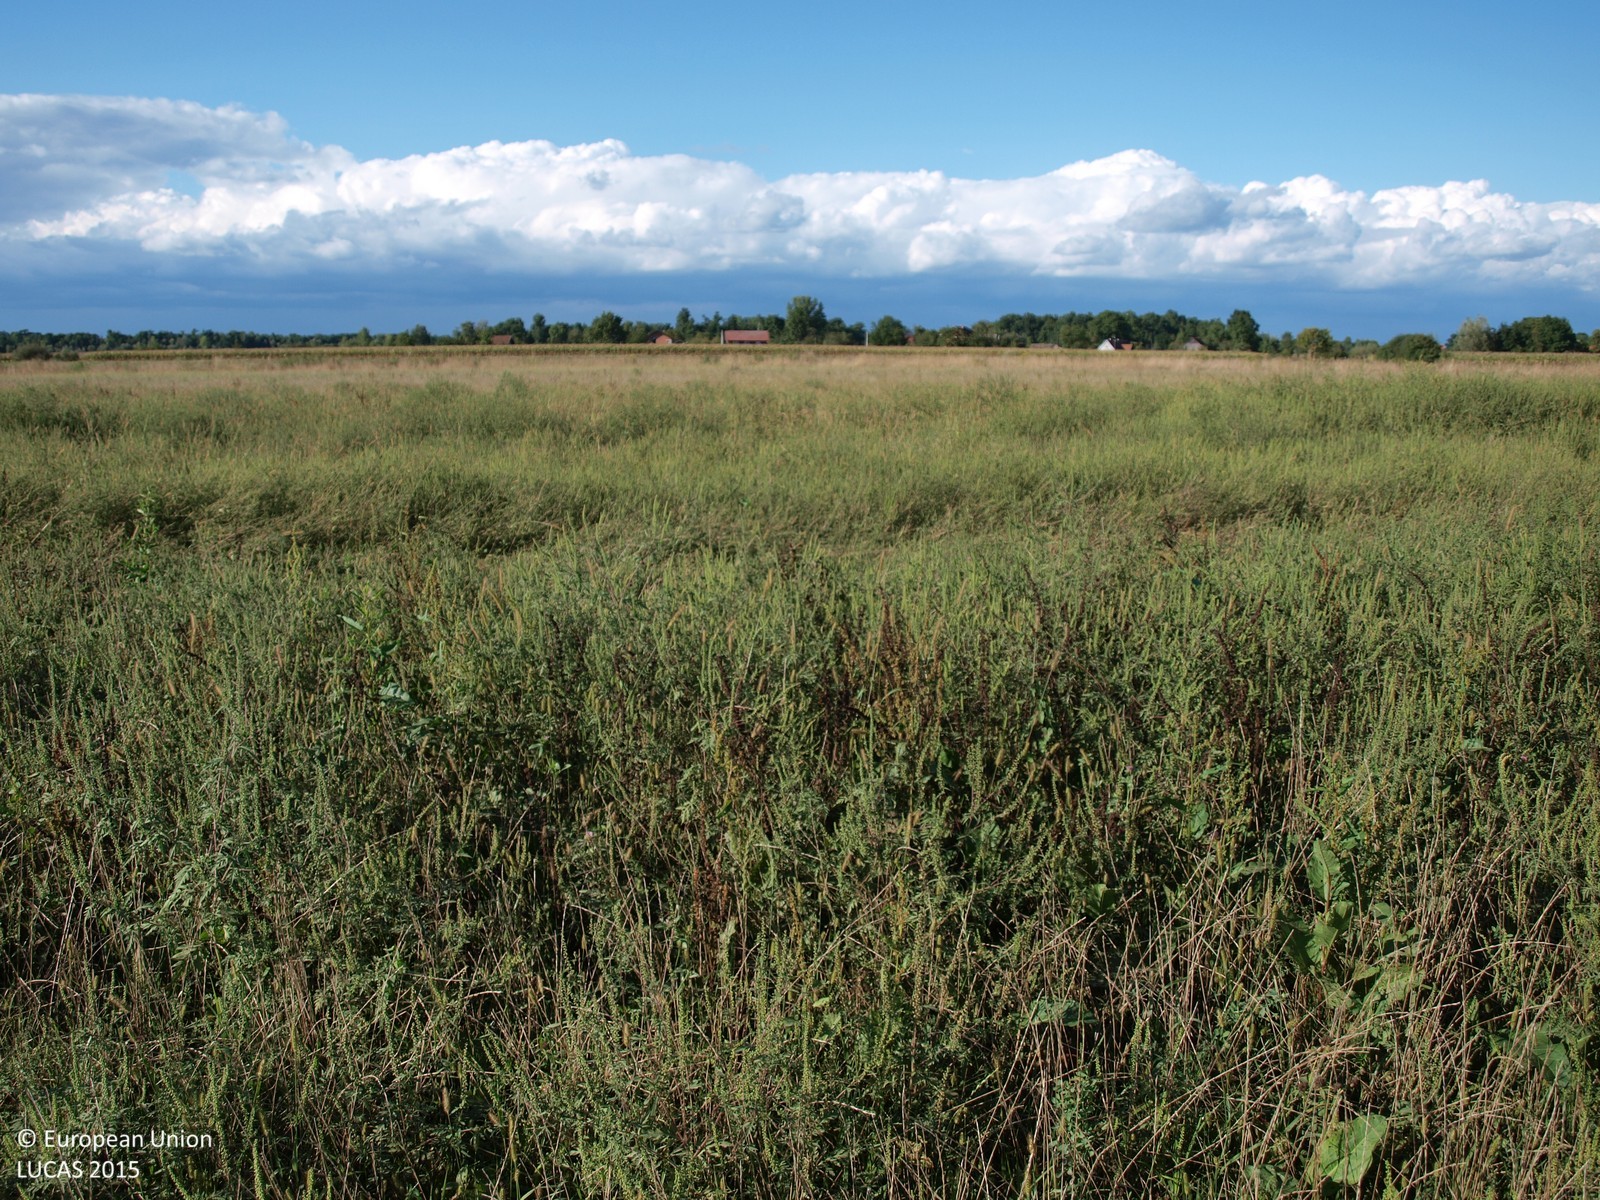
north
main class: Grassland
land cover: Spontaneously vegetated surfaces
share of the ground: > 75 %
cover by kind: herbaceous plants 100 %
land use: Fallow land
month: September
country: HR
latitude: 45.7134
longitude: 16.3059
